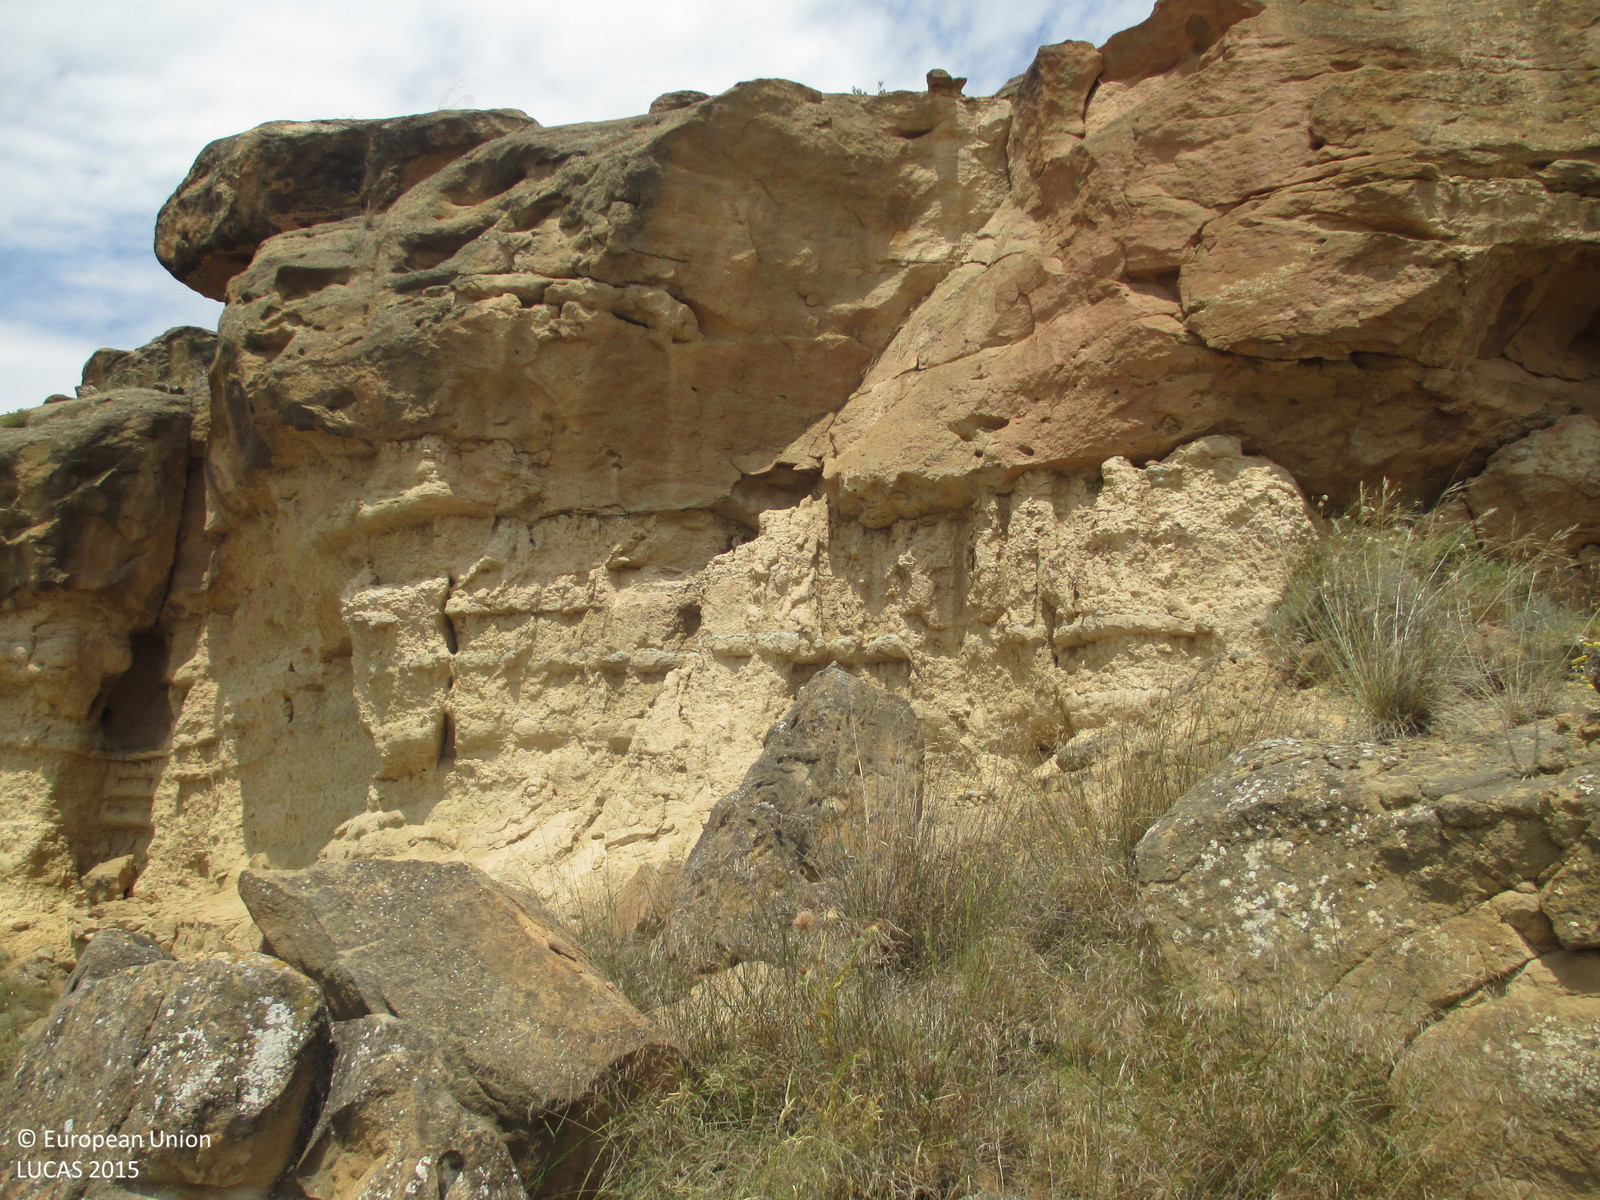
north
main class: Shrubland
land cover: Shrubland without tree cover
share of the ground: > 75 %
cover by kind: shrubs 90 %, herbaceous plants 10 %
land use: Semi-natural and natural areas not in use
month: May
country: ES
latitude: 41.9341
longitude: -0.2348
